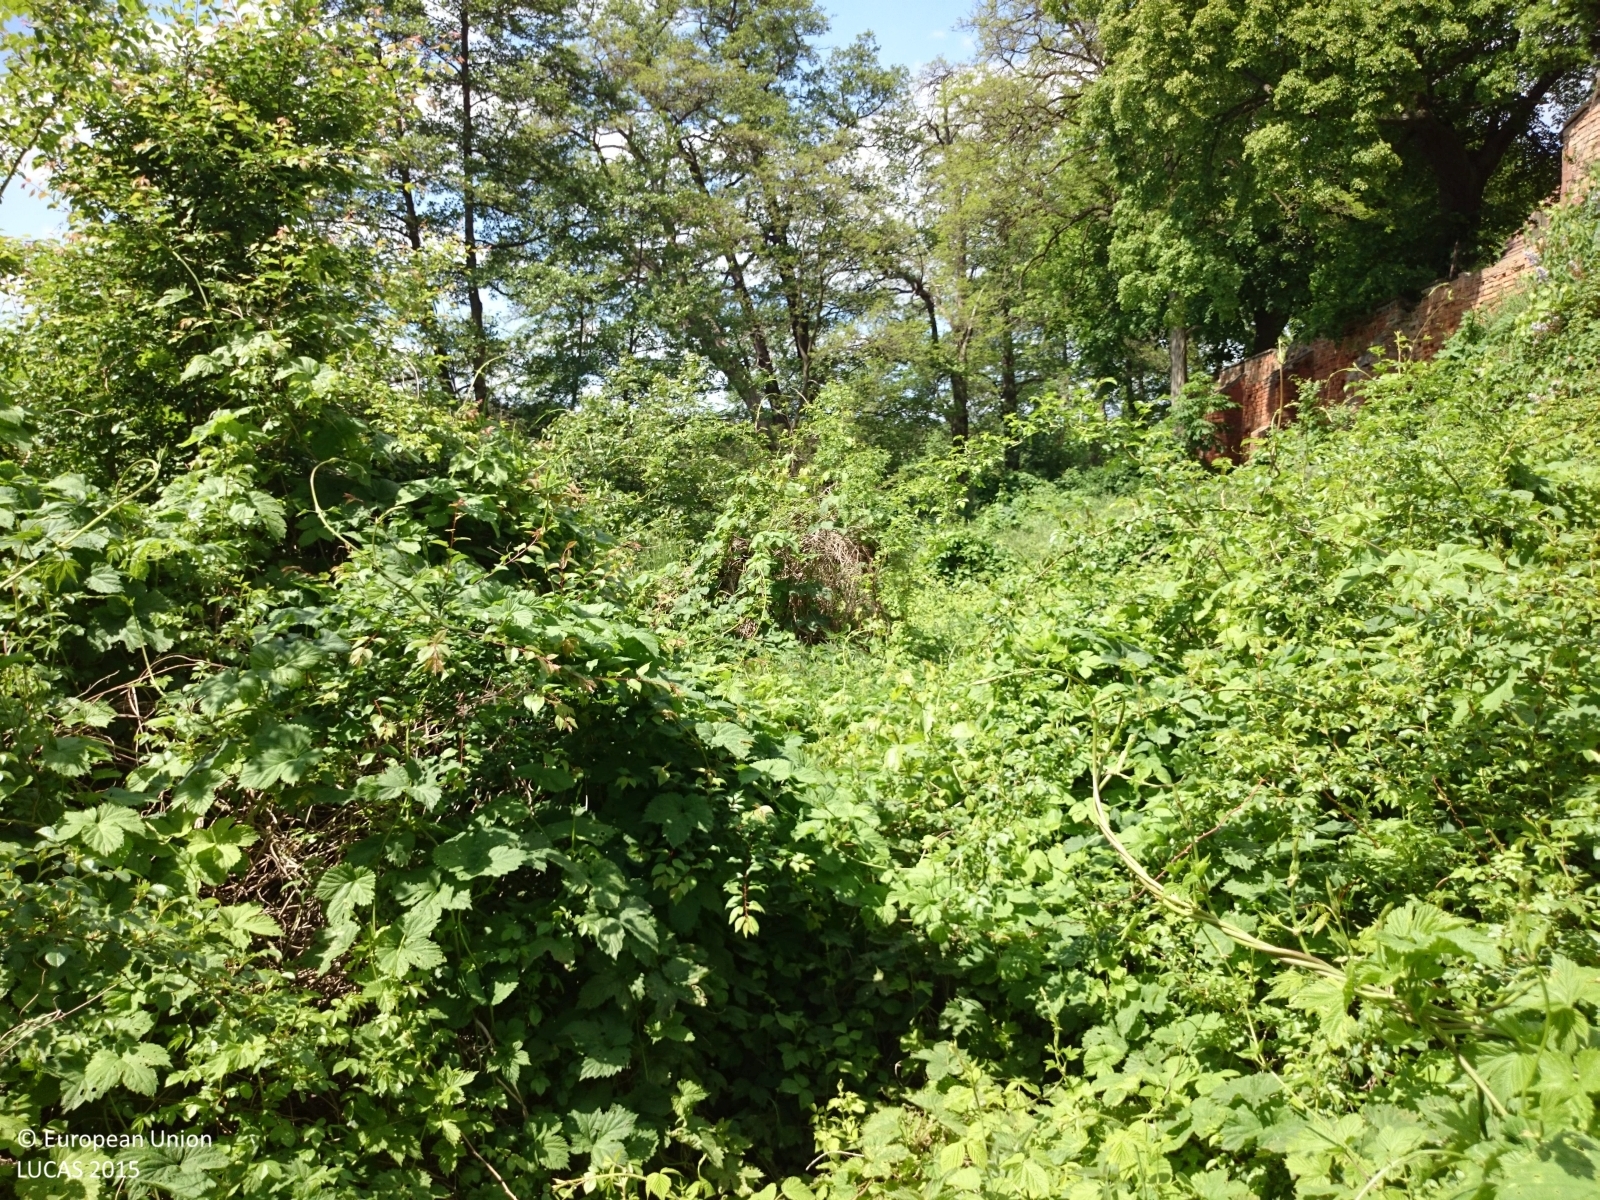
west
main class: Shrubland
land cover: Shrubland with sparse tree cover
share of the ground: > 75 %
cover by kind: shrubs 85 %, herbaceous plants 10 %, broadleaved forest trees 5 %
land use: Abandoned areas
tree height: > 5 m
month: May
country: PL
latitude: 52.4417
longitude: 15.6388
